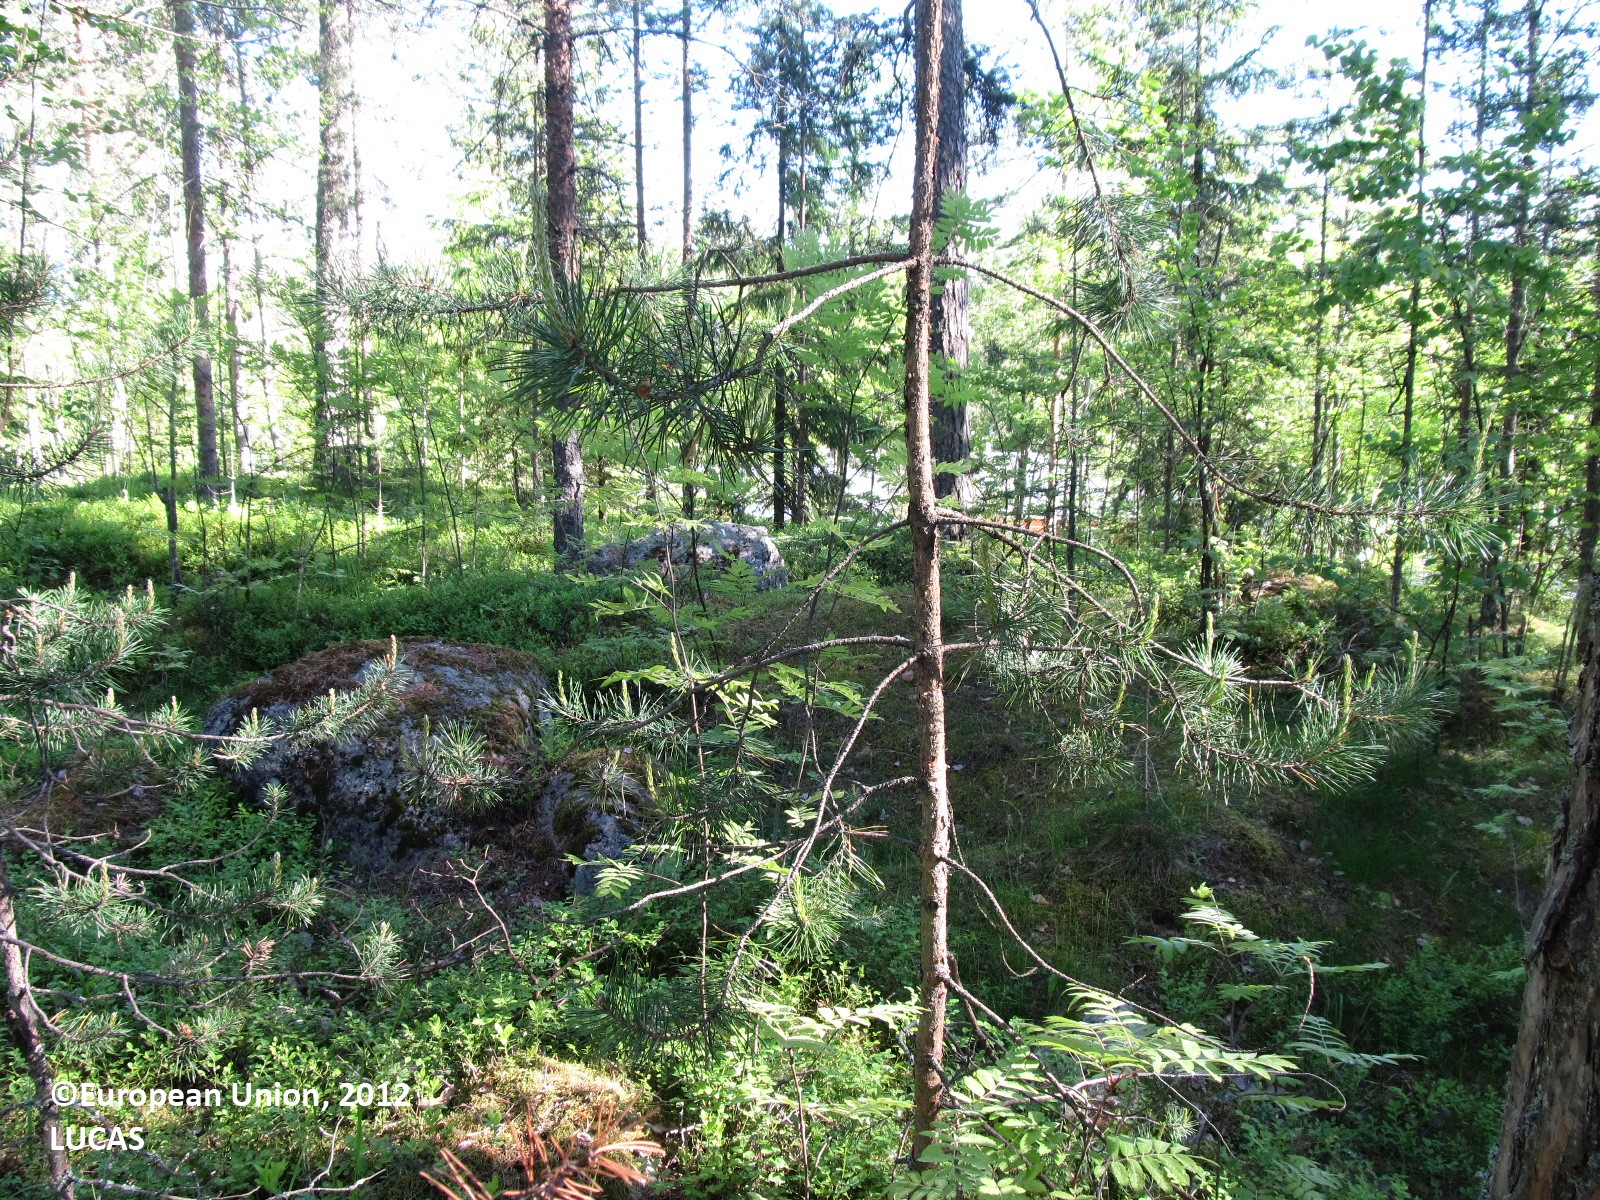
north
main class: Woodland
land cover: Pine dominated coniferous woodland
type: boreal forest
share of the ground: 25 - 50 %
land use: Sport
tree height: > 5 m
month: June
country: FI
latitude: 62.8755
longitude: 27.6455
